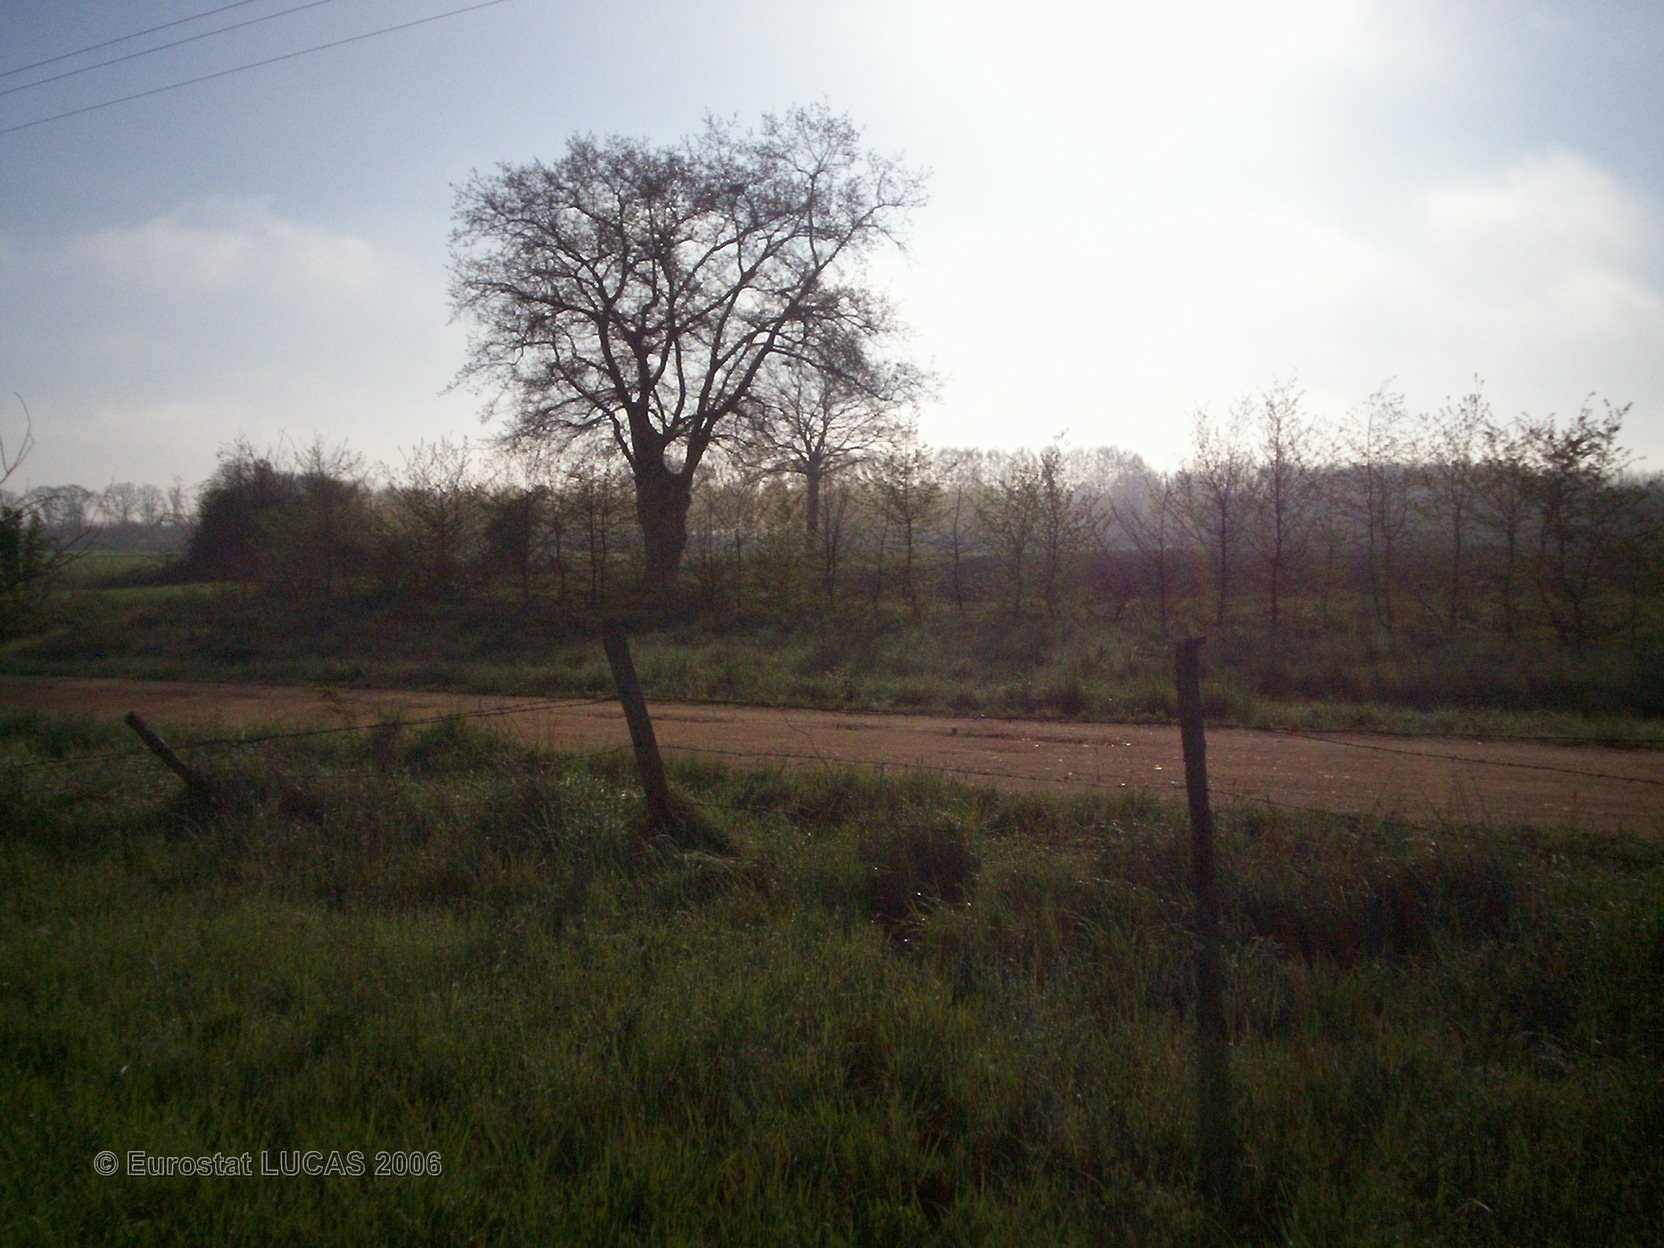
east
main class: Grassland
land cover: Grassland without tree/shrub cover
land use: Agriculture (excluding fallow land and kitchen gardens)
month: April
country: FR
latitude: 47.4922
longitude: -0.4231
